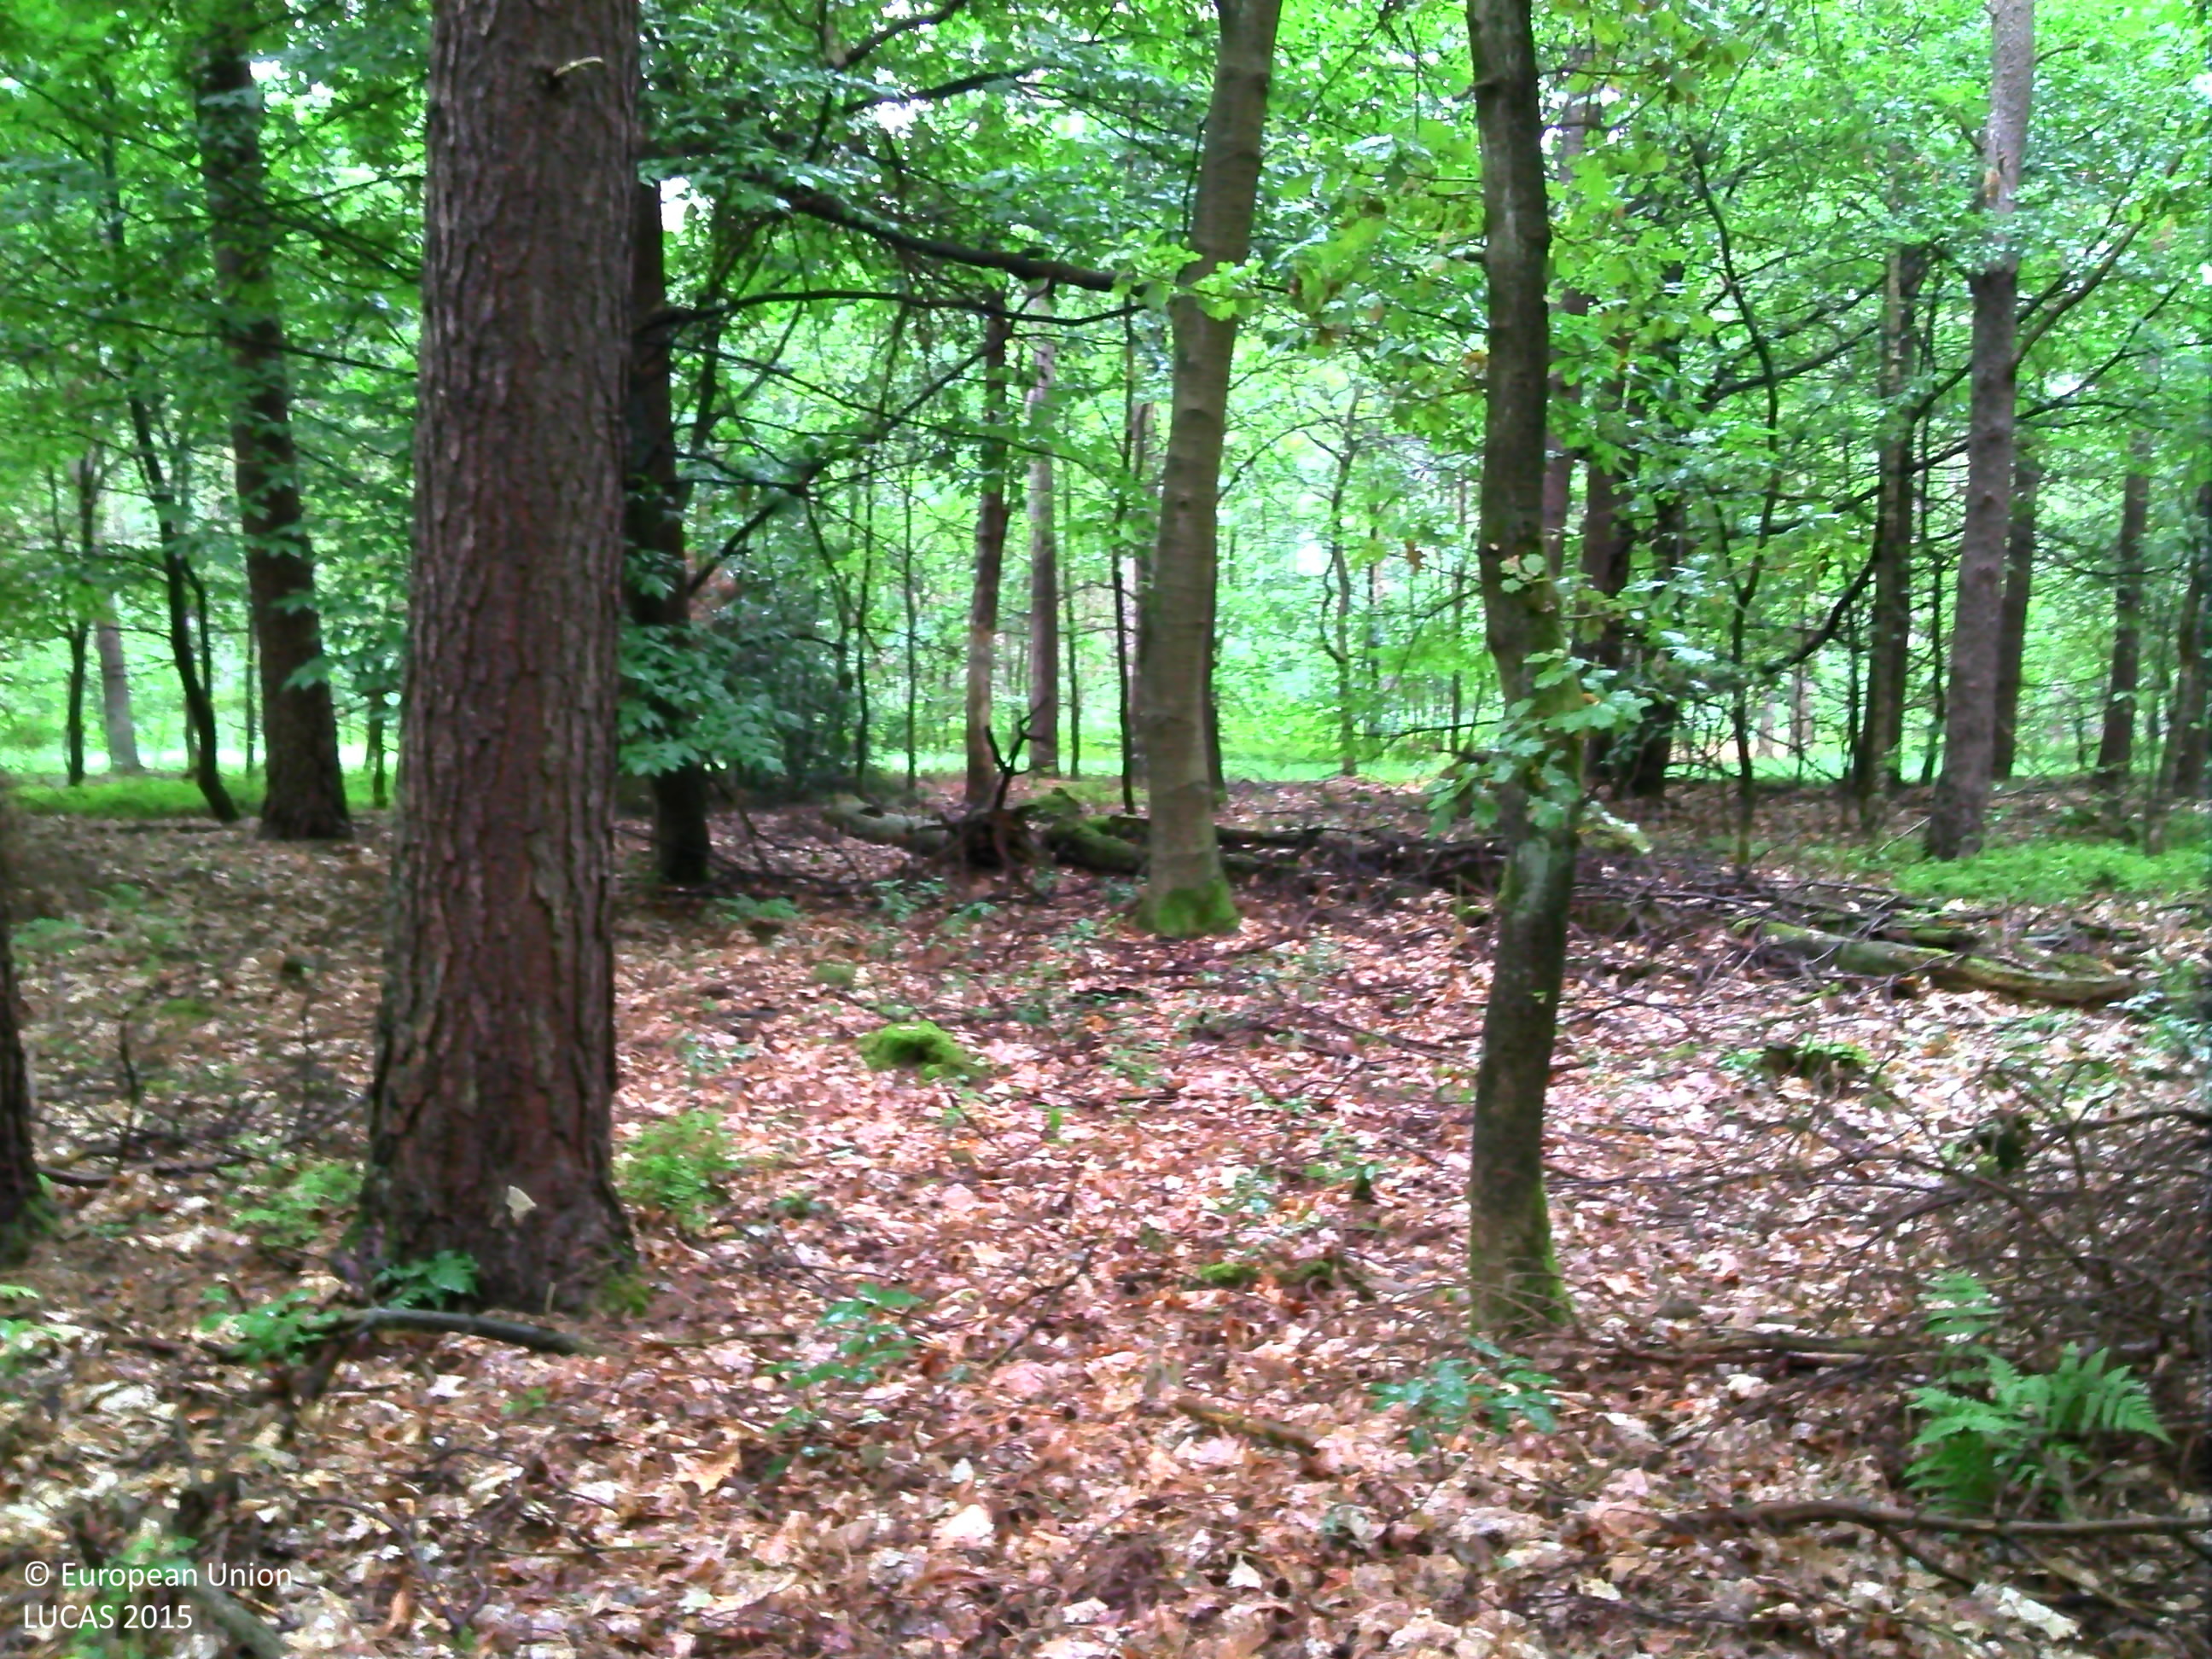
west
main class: Woodland
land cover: Pine dominated mixed woodland
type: mesophytic deciduous forest
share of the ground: > 75 %
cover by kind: coniferous forest trees 65 %, broadleaved forest trees 35 %
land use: Forestry
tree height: > 5 m
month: August
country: BE
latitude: 50.9805
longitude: 5.5685
